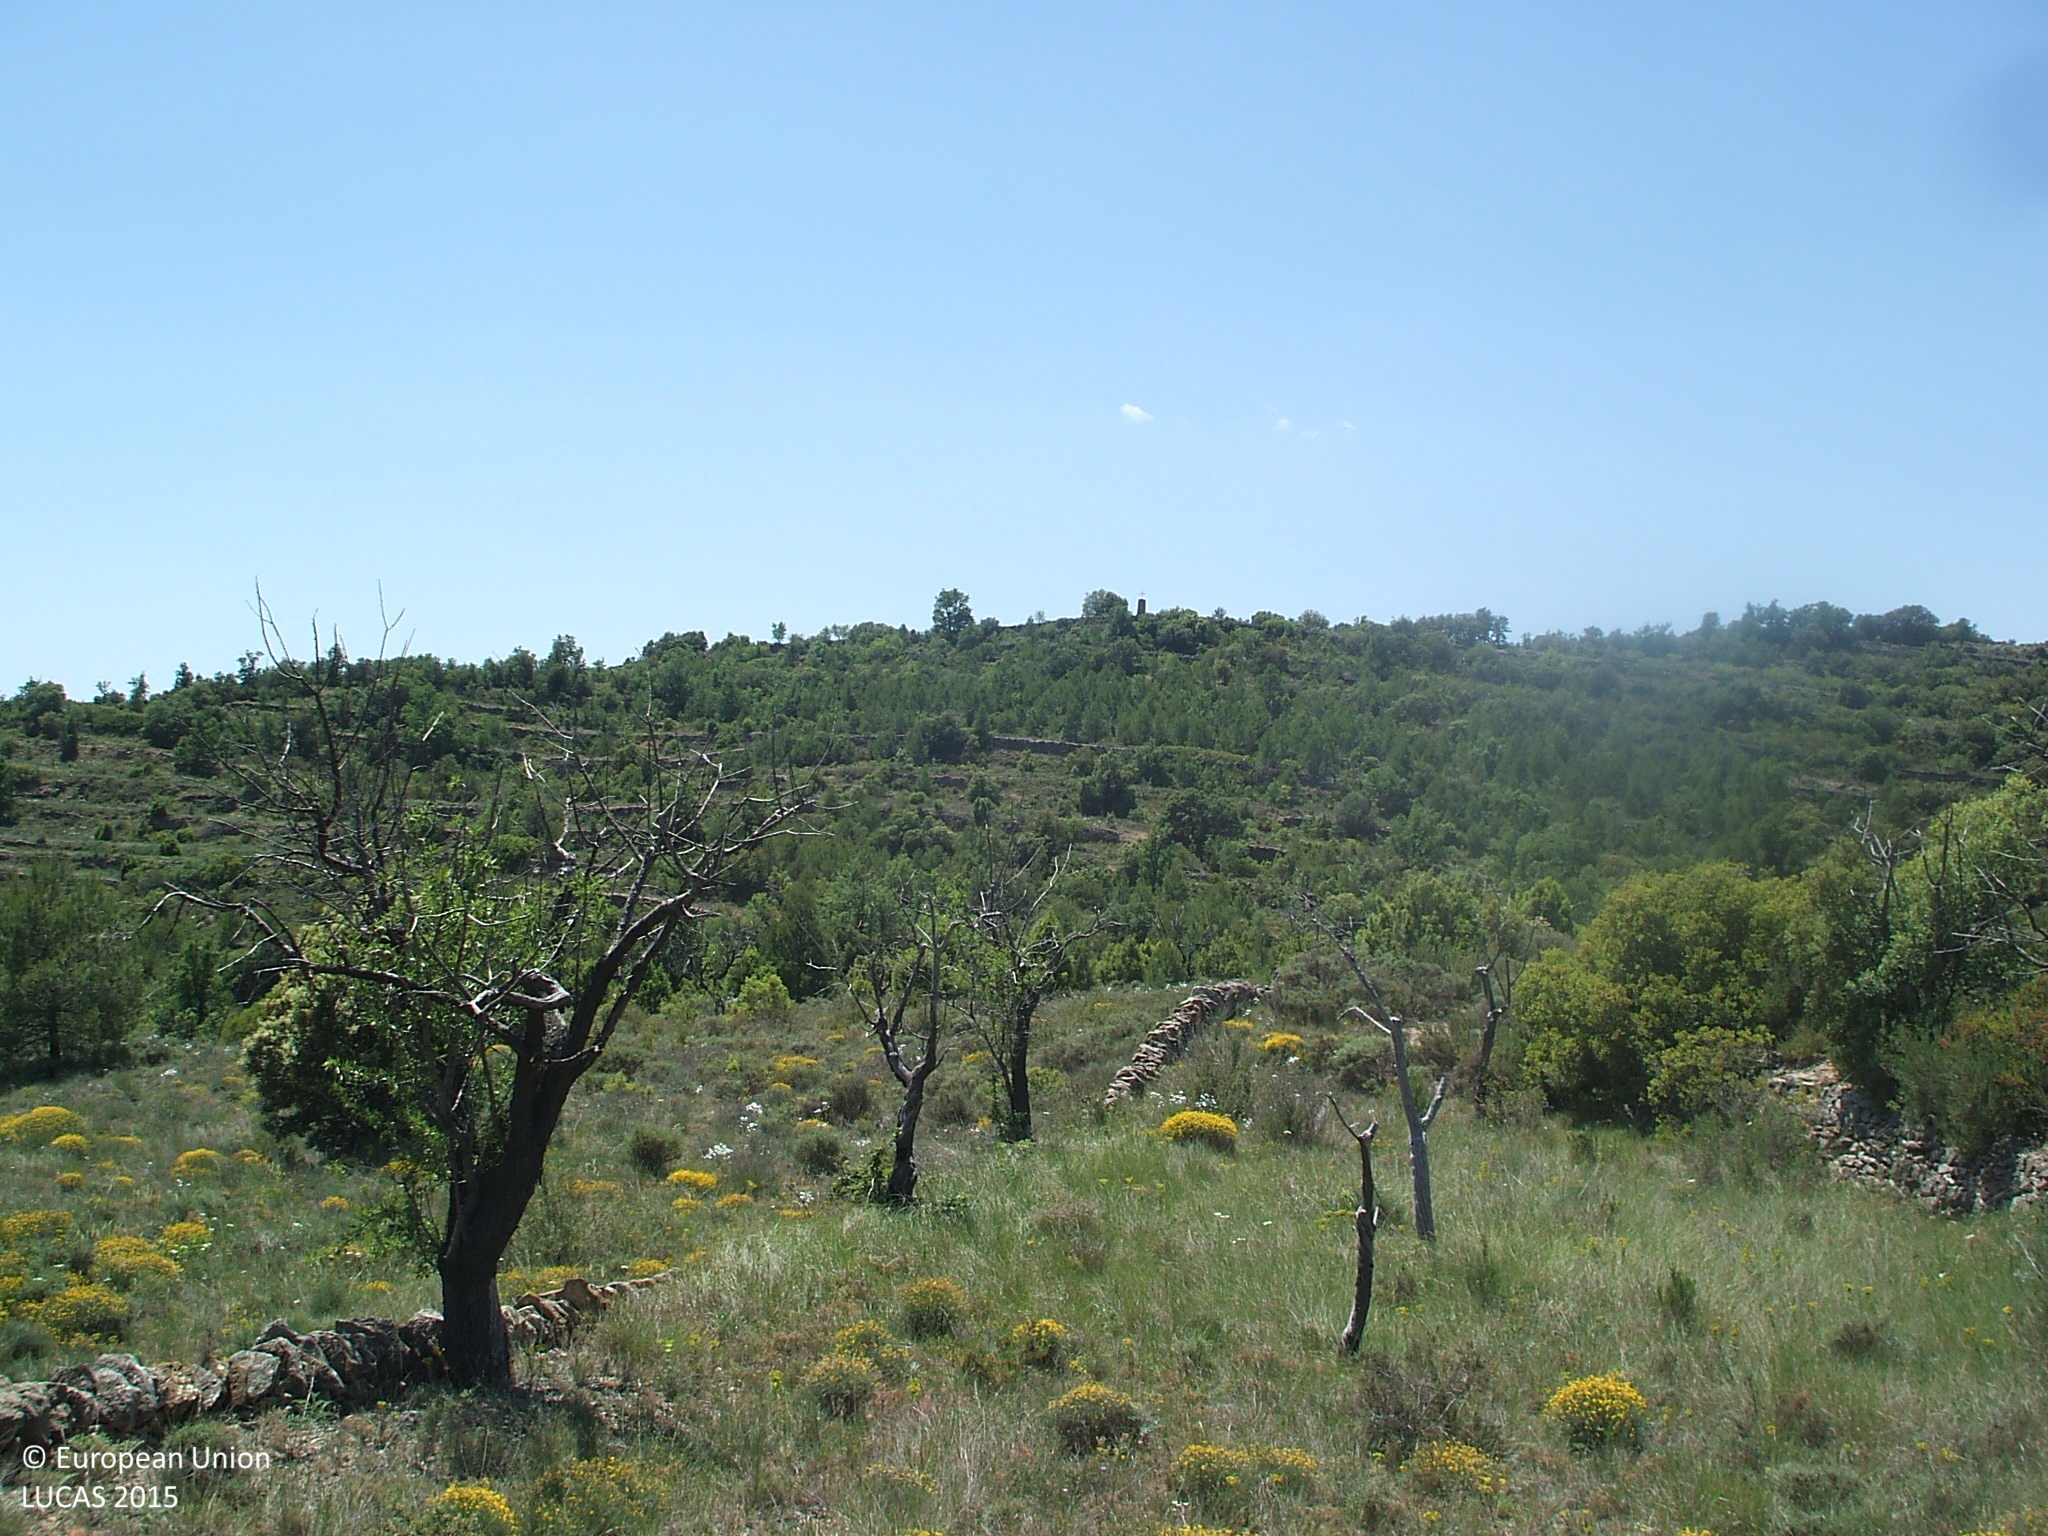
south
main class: Shrubland
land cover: Shrubland with sparse tree cover
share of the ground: 50 - 75 %
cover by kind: shrubs 70 %, unconsolidated bare surface 25 %, broadleaved forest trees 5 %
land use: Semi-natural and natural areas not in use
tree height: > 5 m
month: May
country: ES
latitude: 40.6797
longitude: -0.2190
